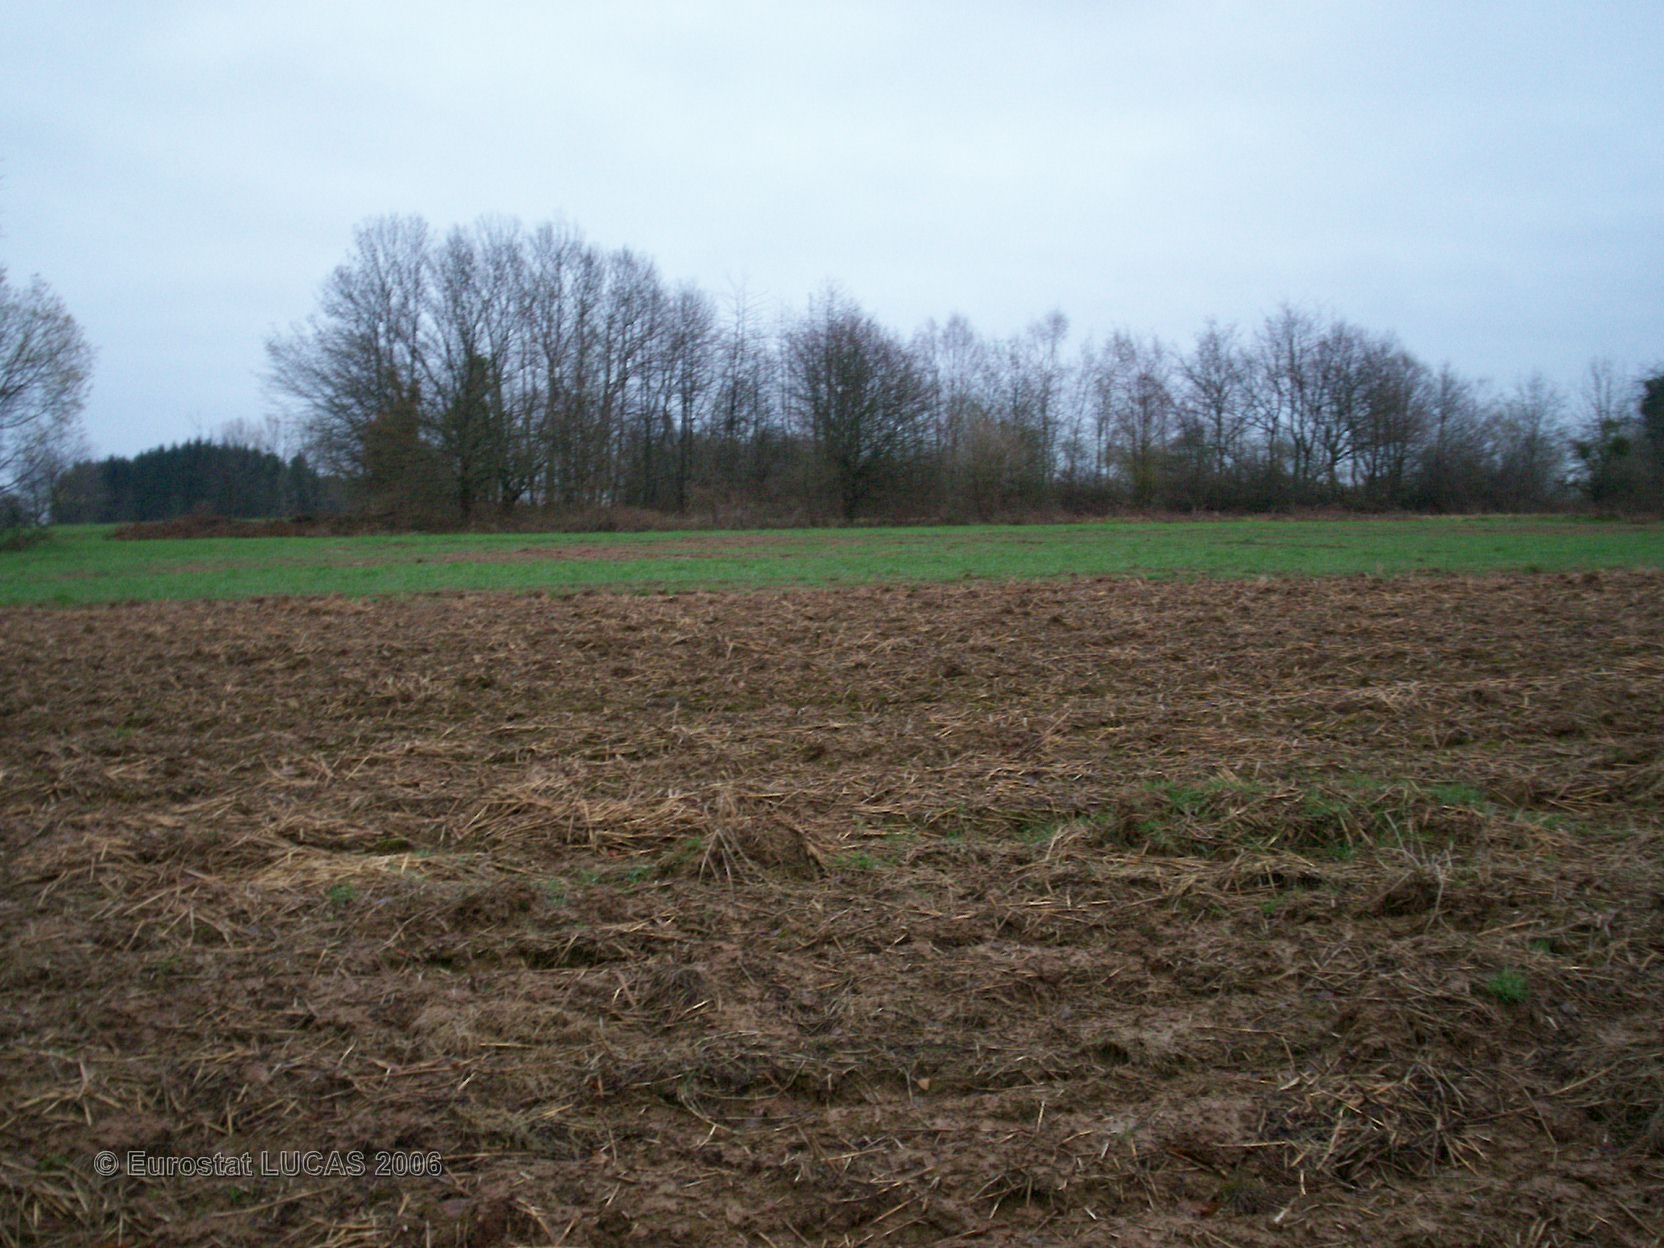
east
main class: Grassland
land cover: Grassland without tree/shrub cover
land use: Agriculture (excluding fallow land and kitchen gardens)
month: April
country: FR
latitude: 47.6122
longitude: 6.5825
